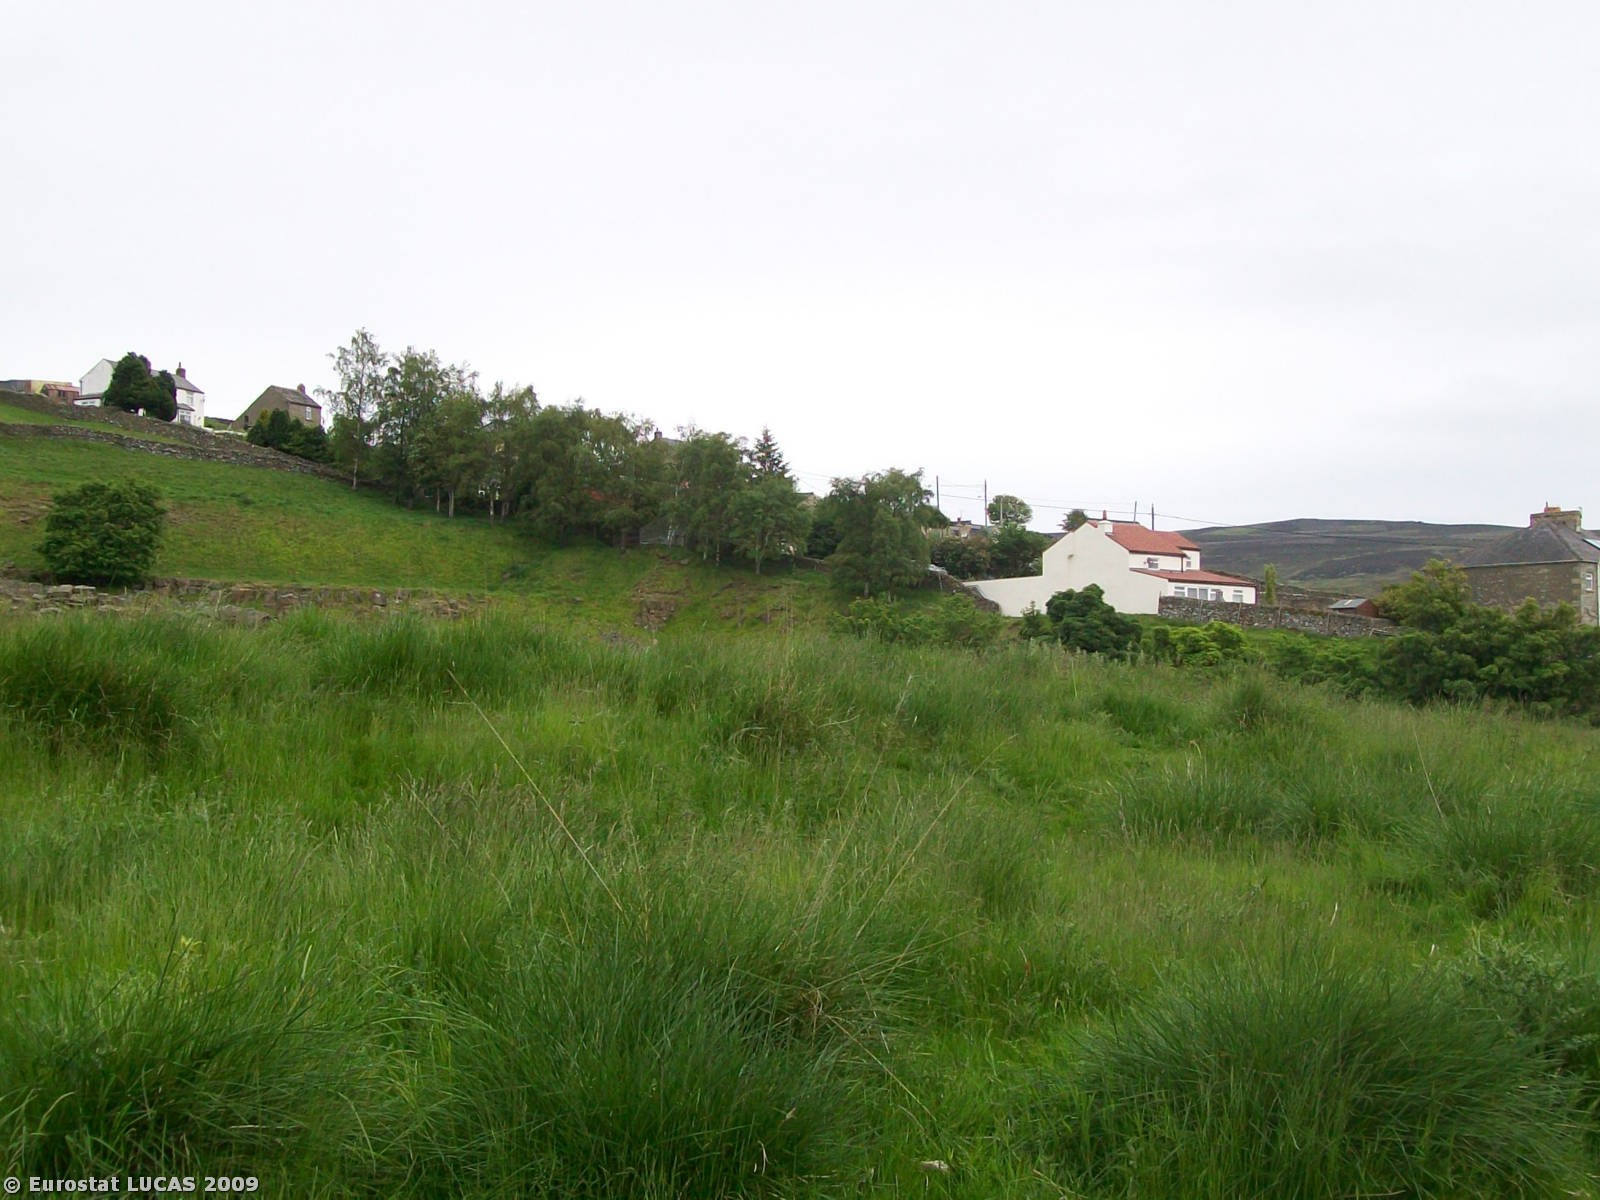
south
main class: Grassland
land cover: Grassland without tree/shrub cover
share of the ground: > 75 %
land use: Agriculture (excluding fallow land and kitchen gardens)
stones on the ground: < 10 %
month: June
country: GB
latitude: 54.7486
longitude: -2.0023
